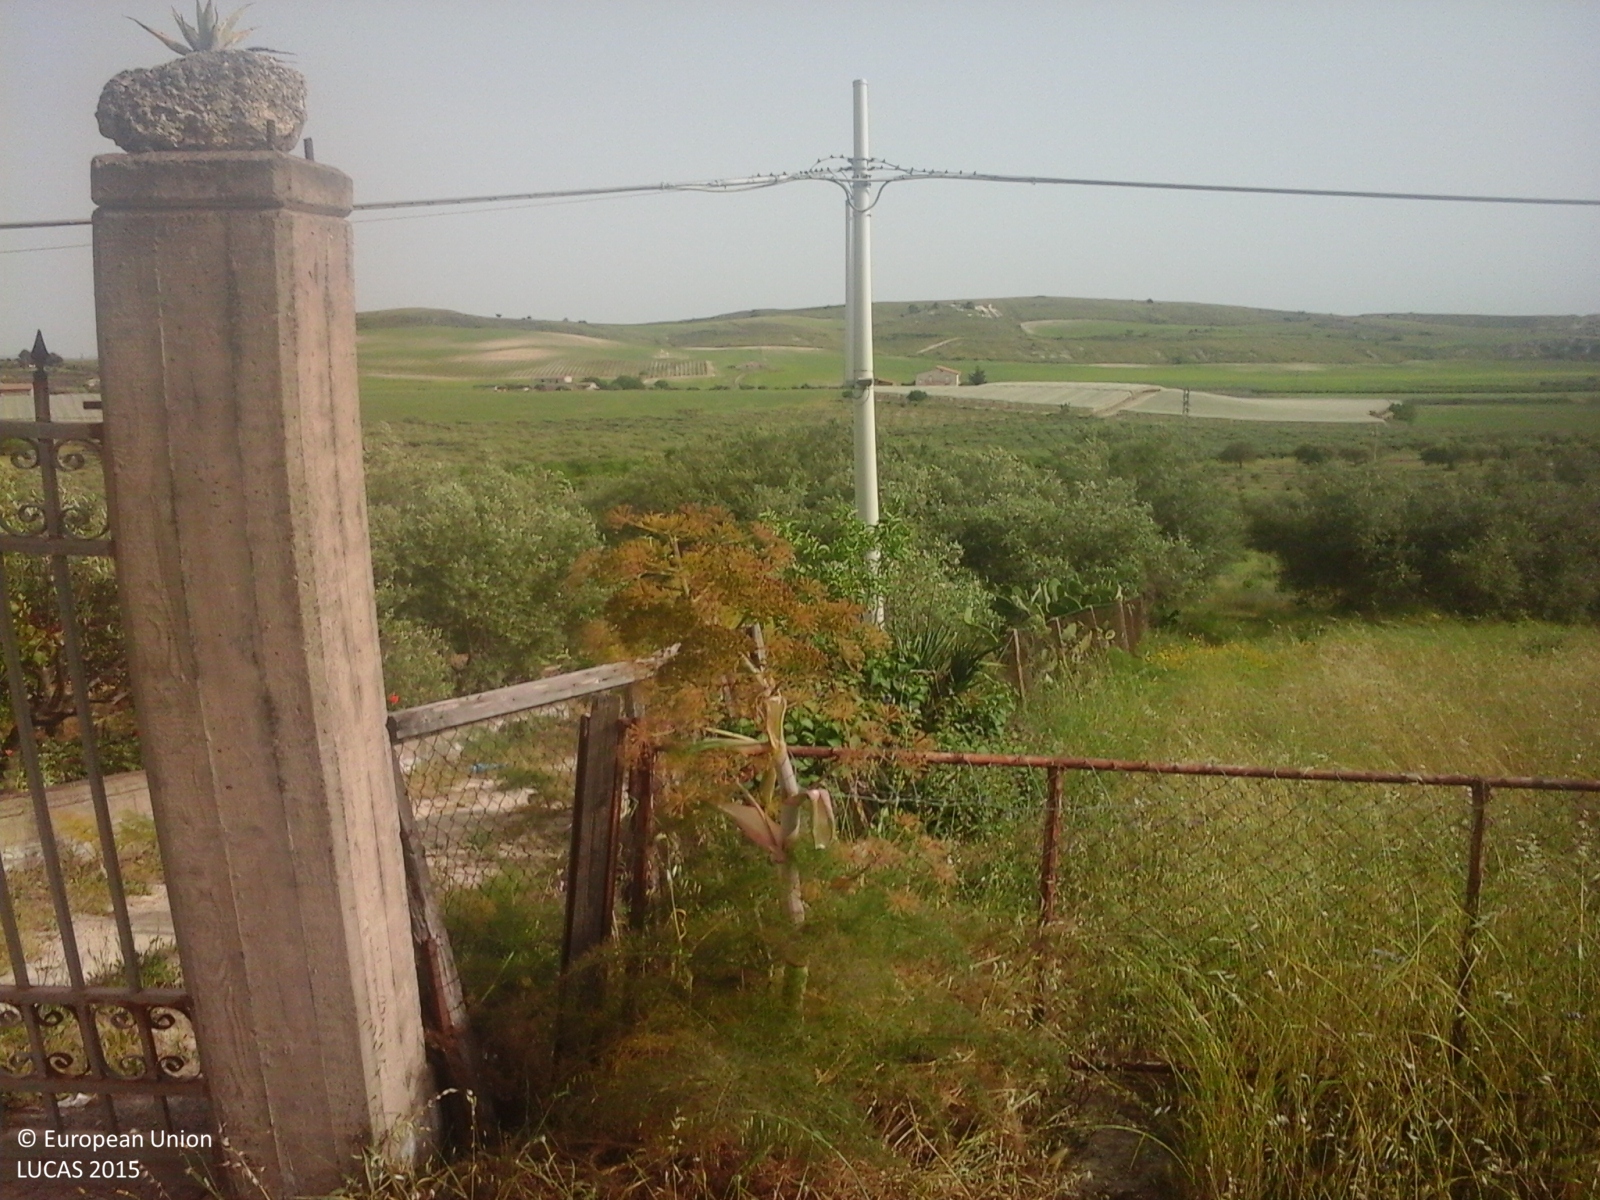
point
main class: Cropland
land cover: Olive groves
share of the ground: > 75 %
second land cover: Spontaneously vegetated surfaces
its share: > 75 %
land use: Agriculture (excluding fallow land and kitchen gardens)
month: May
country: IT
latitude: 37.4660
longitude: 13.9388
